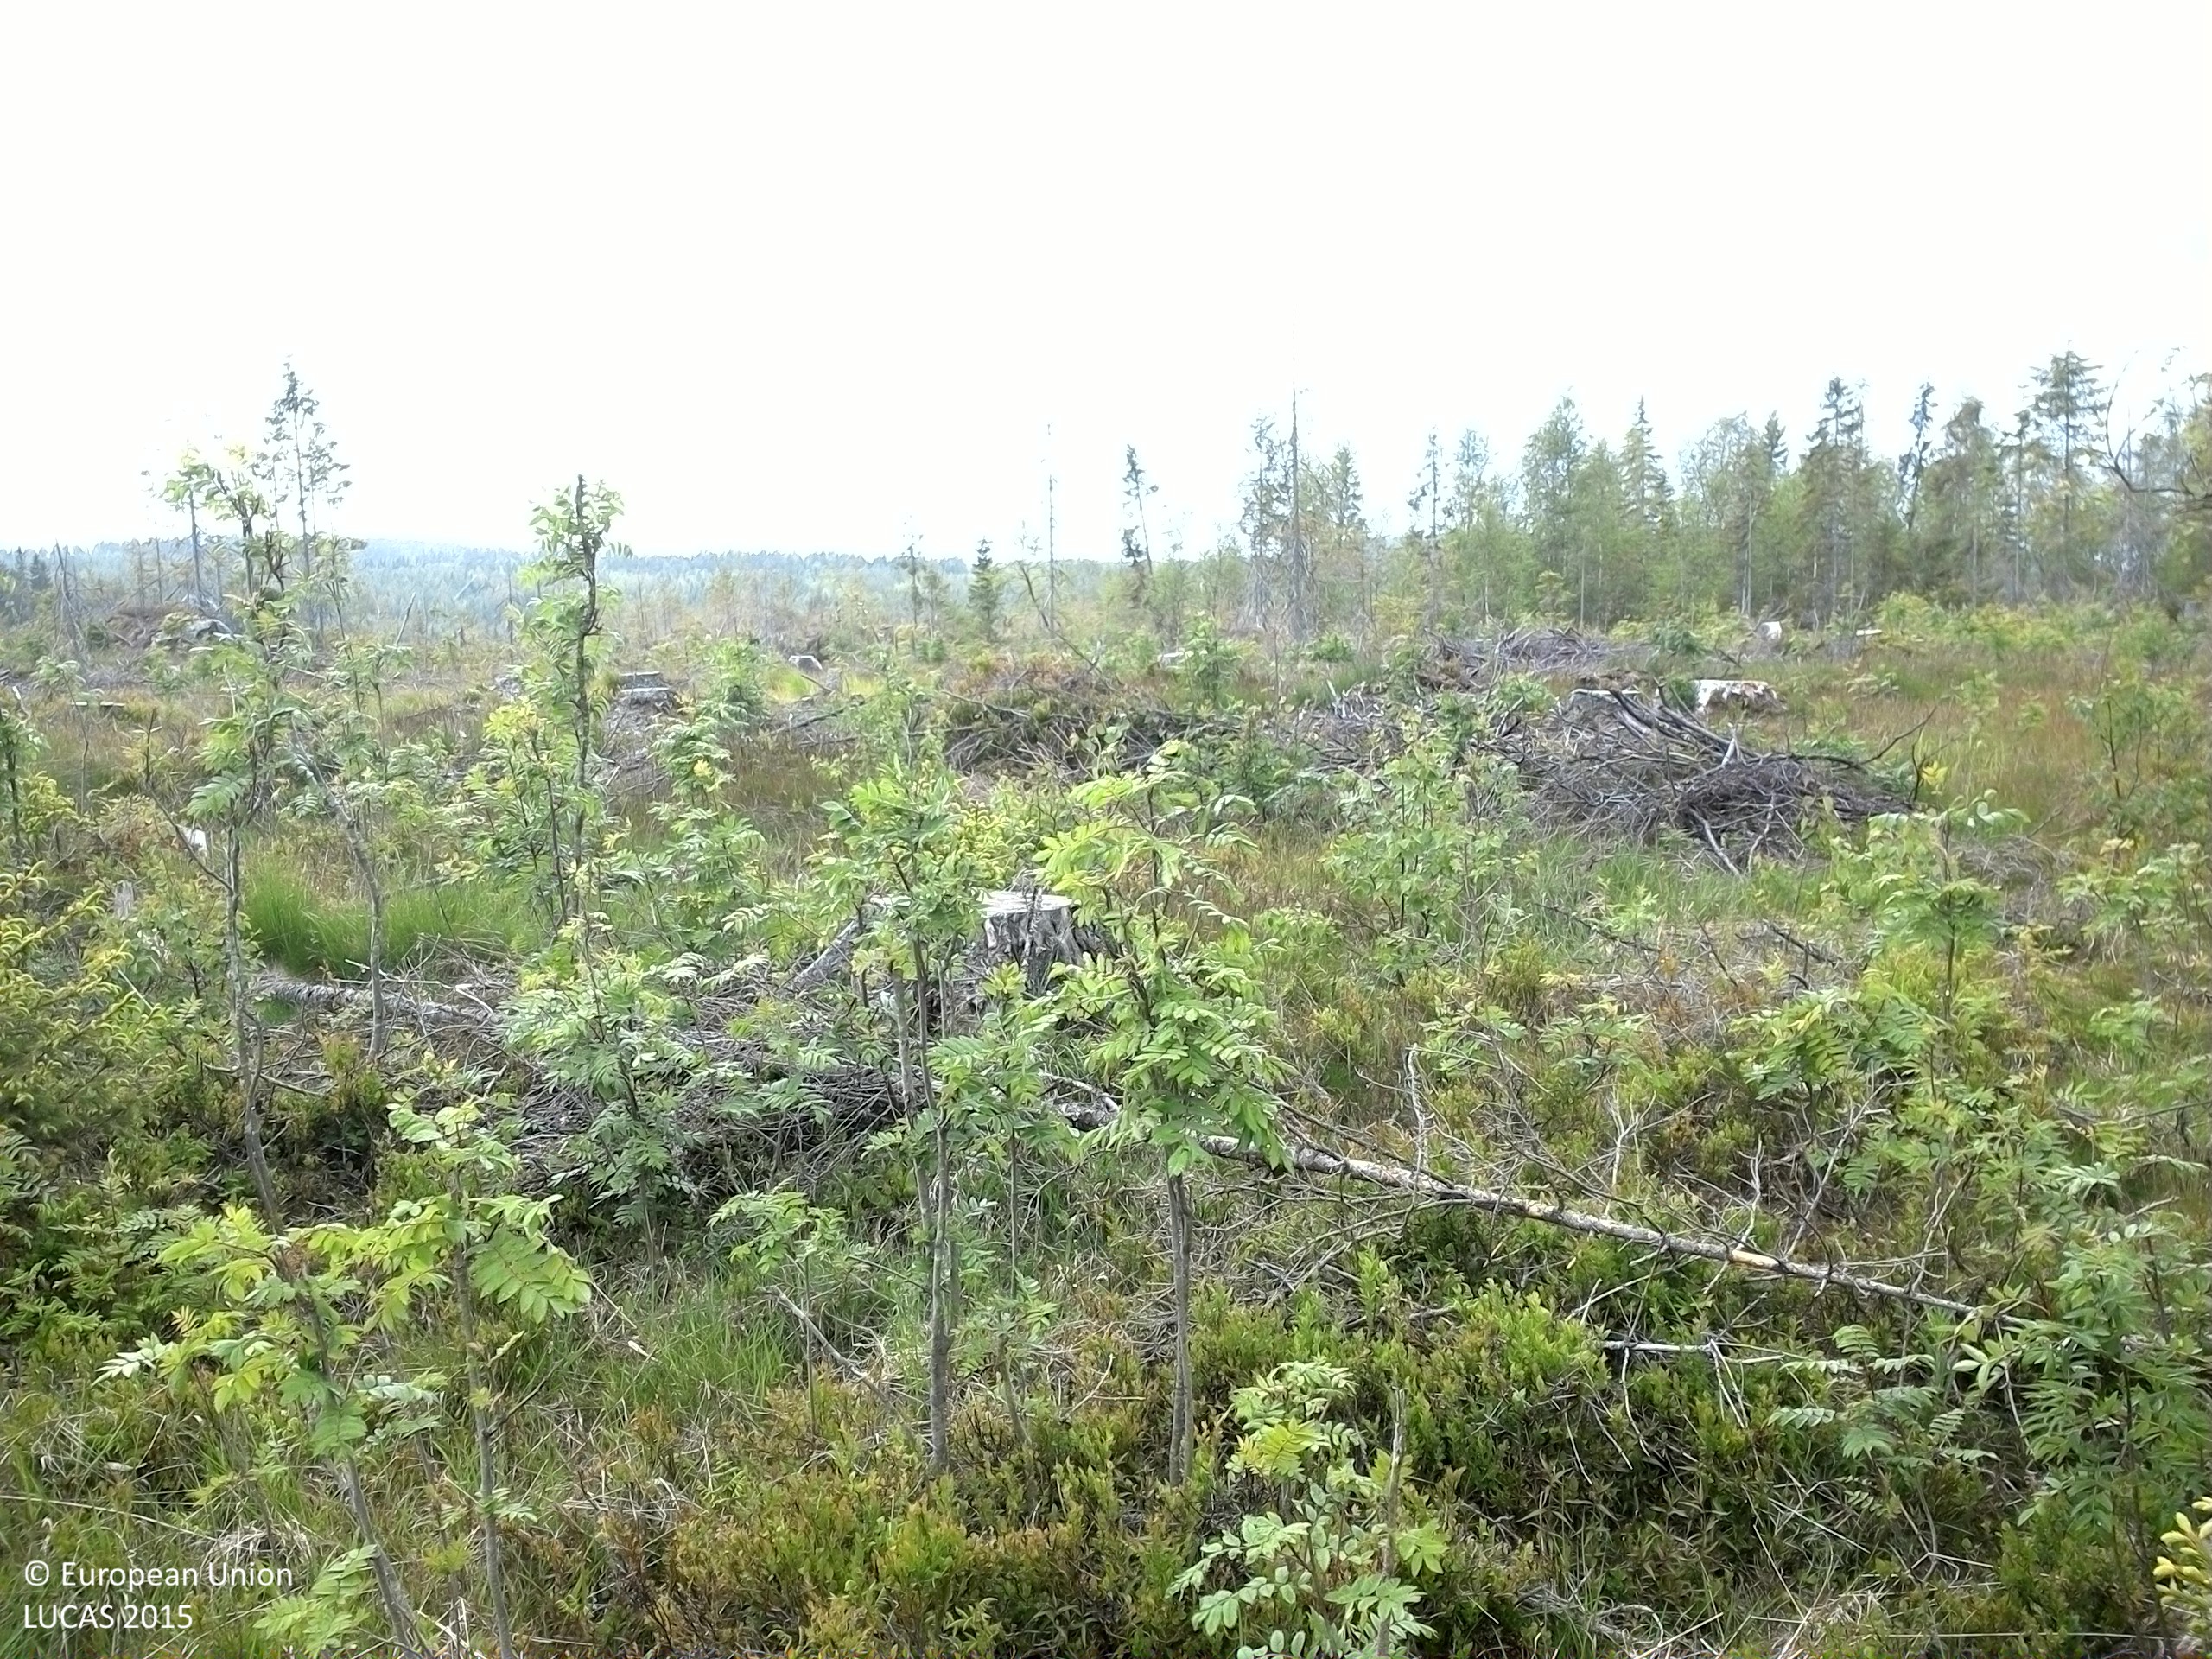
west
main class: Woodland
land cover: Spruce dominated mixed woodland
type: boreal forest
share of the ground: 10 - 25 %
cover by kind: herbaceous plants 65 %, coniferous forest trees 15 %, broadleaved forest trees 10 %, shrubs 10 %
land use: Forestry
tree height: < 5 m
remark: Clear cut
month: June
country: SE
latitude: 62.7033
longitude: 17.7390
